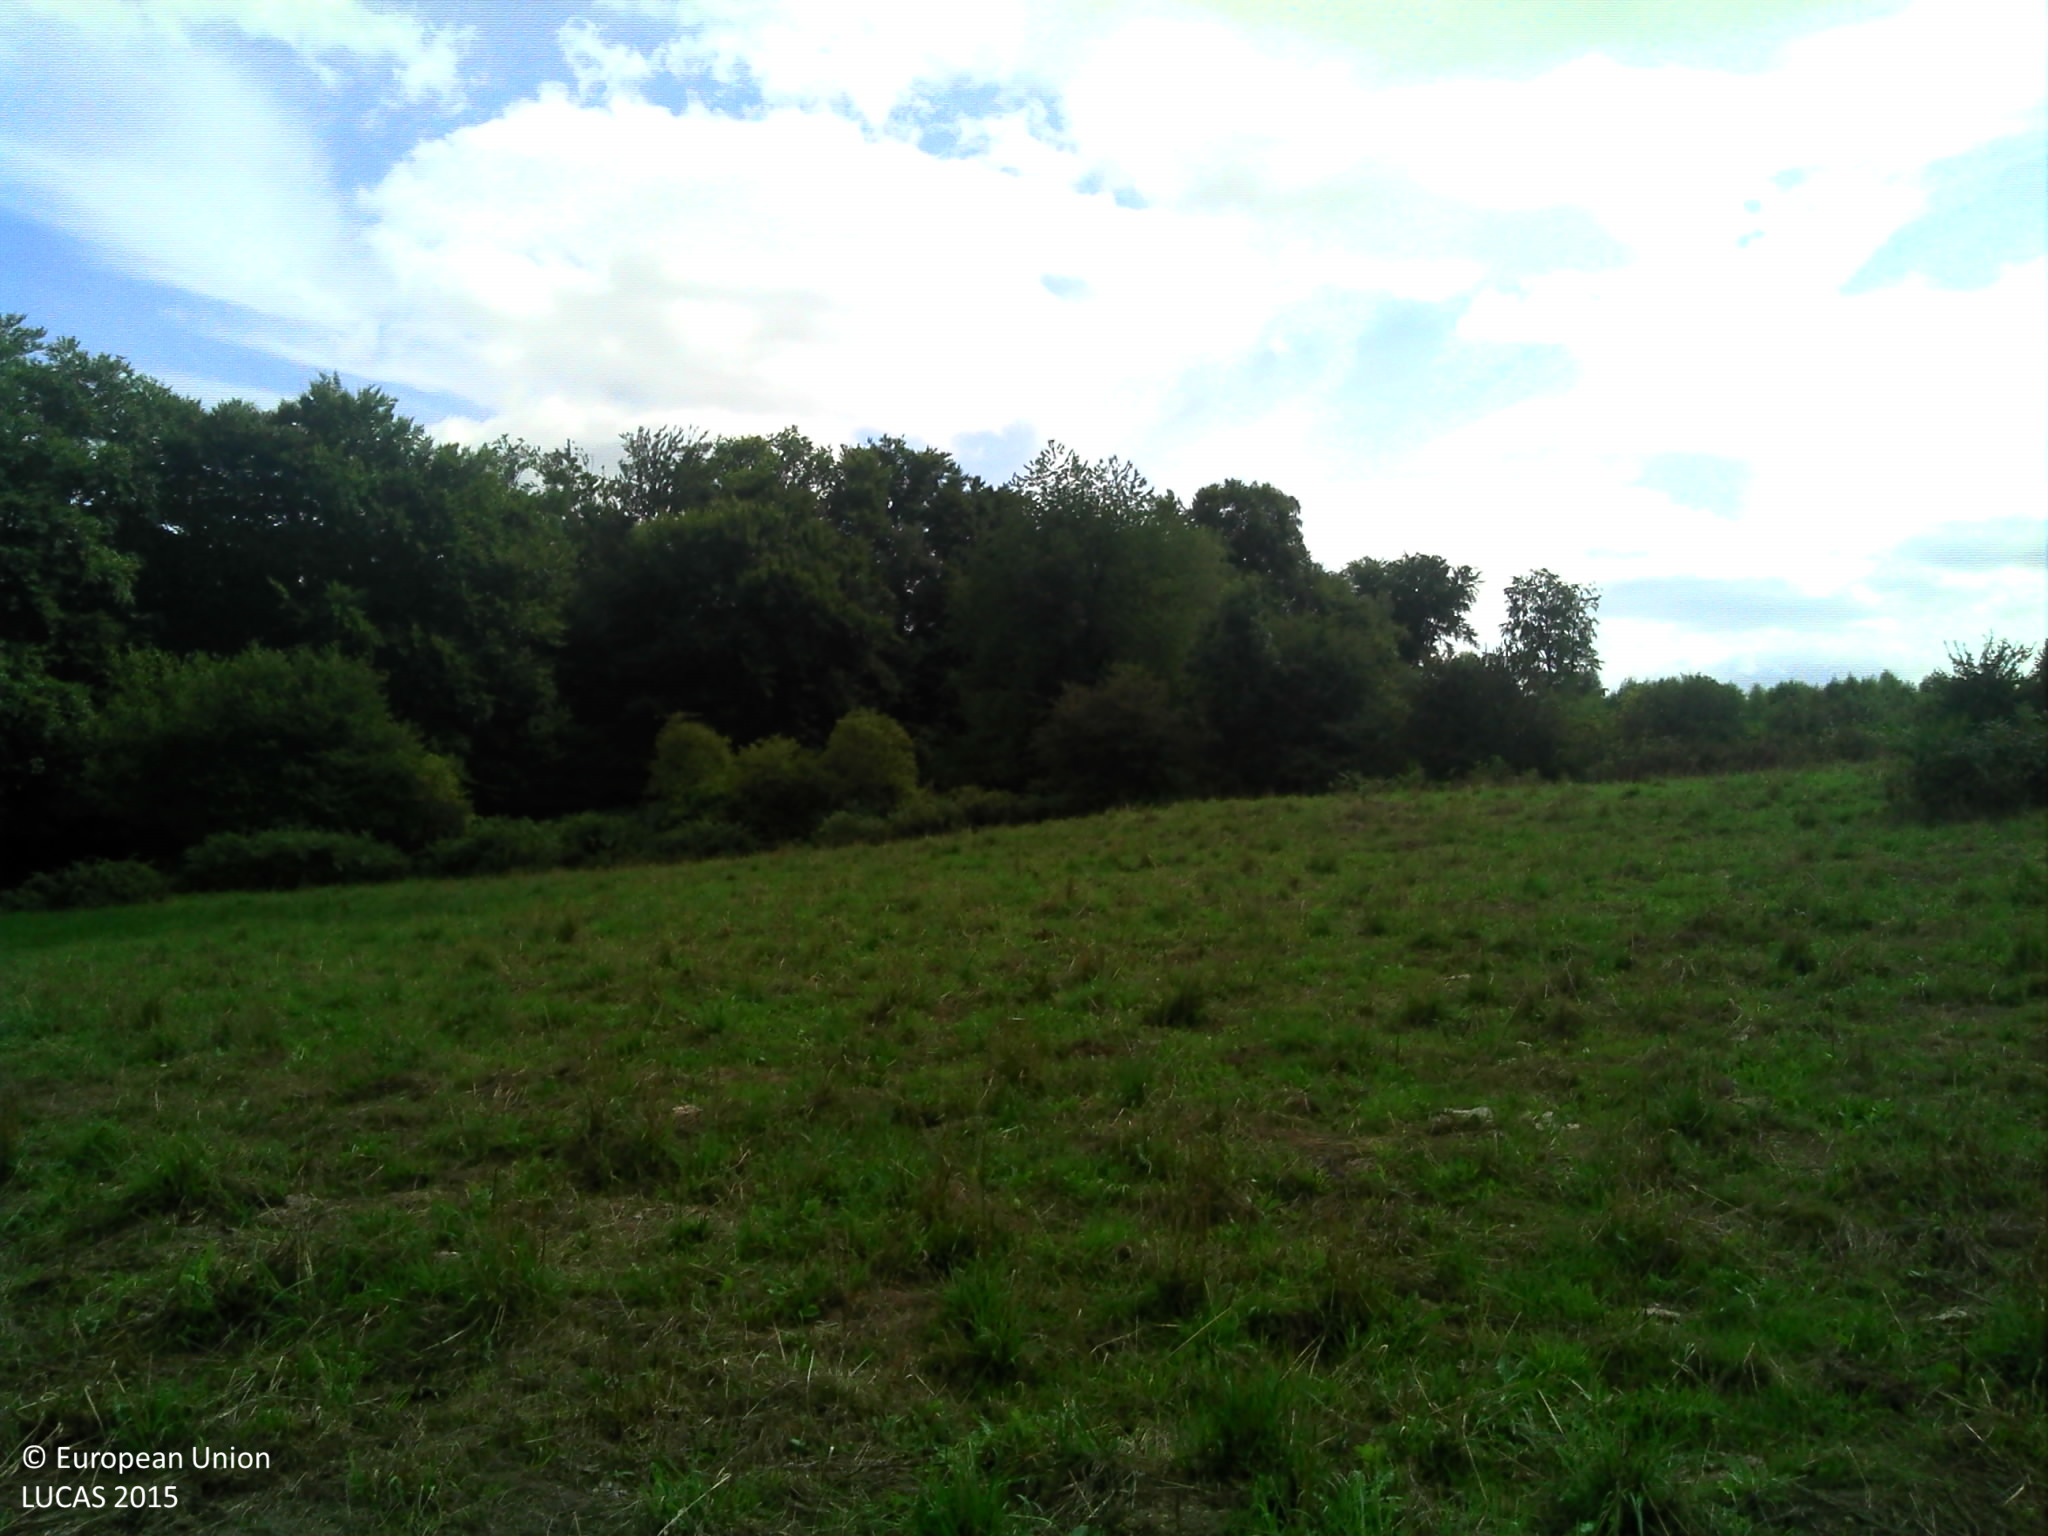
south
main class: Grassland
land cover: Grassland without tree/shrub cover
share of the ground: > 75 %
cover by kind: herbaceous plants 95 %, shrubs 5 %
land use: Agriculture (excluding fallow land and kitchen gardens)
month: August
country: FR
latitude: 45.9963
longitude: 2.2357
